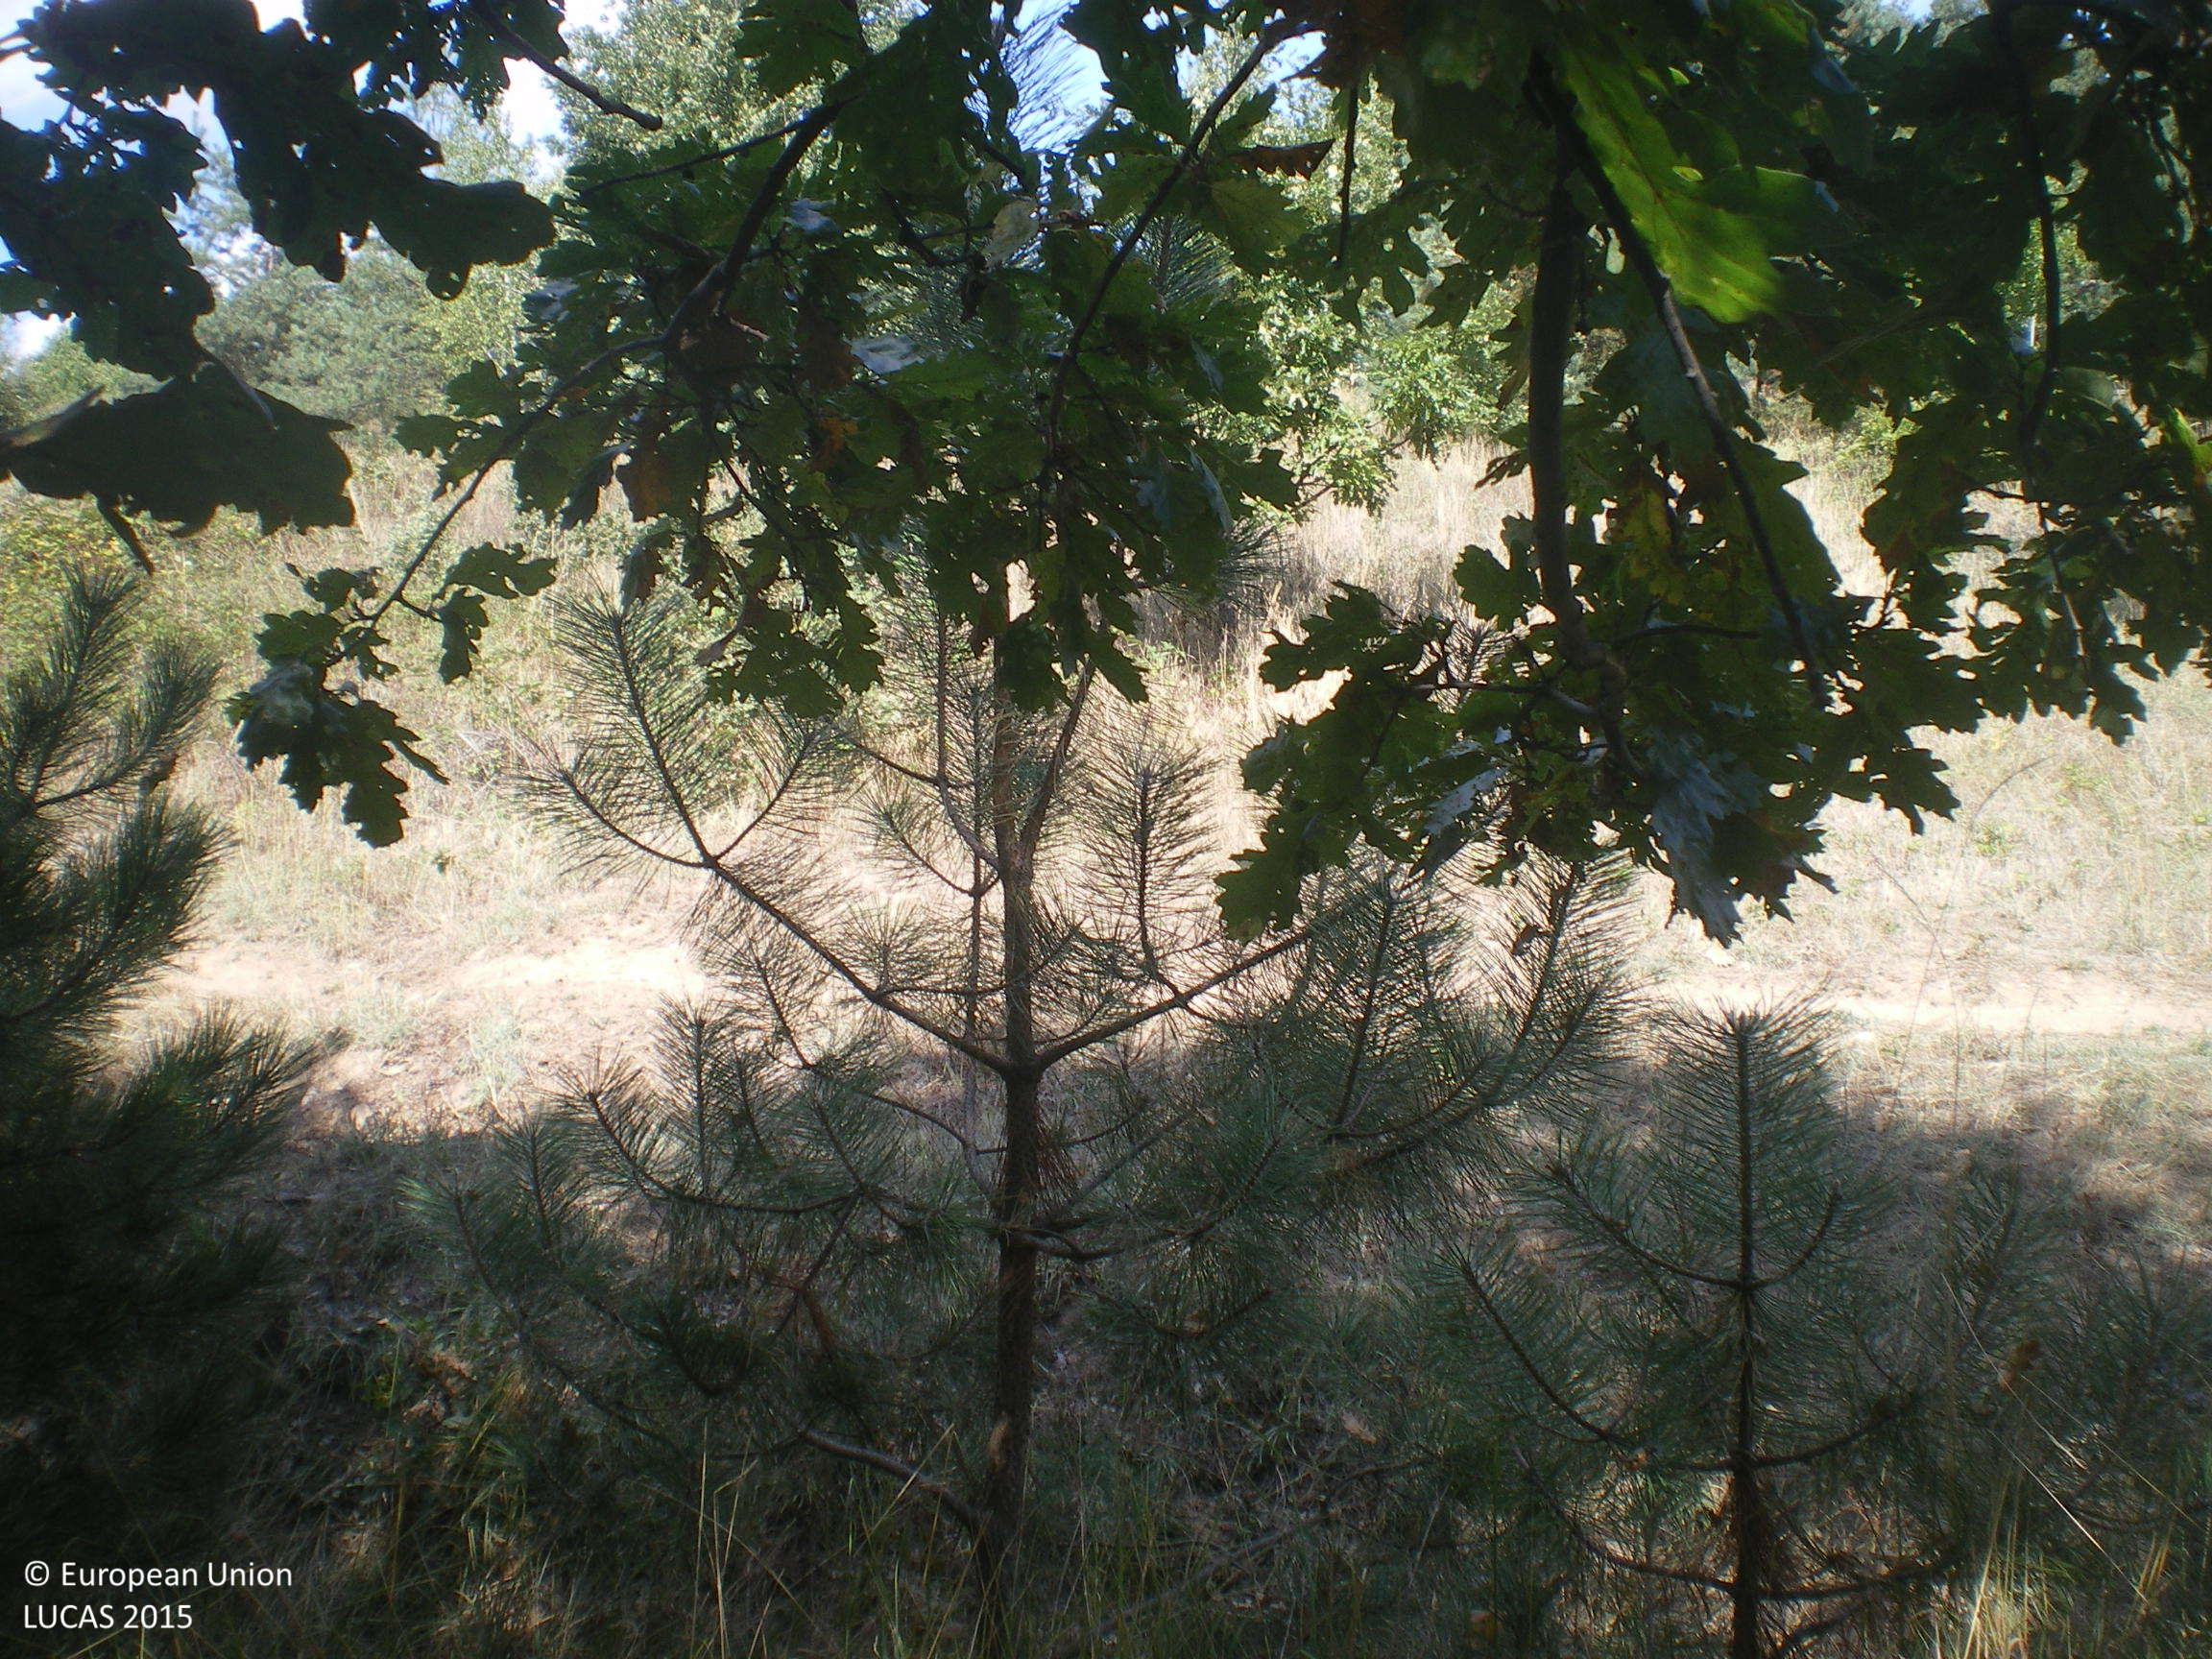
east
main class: Woodland
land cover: Broadleaved woodland
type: mesophytic deciduous forest
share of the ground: > 75 %
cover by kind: broadleaved forest trees 90 %, coniferous forest trees 5 %, herbaceous plants 5 %
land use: Residential
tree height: > 5 m
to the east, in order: Broadleaved woodland; Tracks; Grassland with sparse tree/shrub cover; Broadleaved woodland; Artificial constructions in urban areas; Pine dominated coniferous woodland; Paved roads, cycling and walking lanes; Grass margins; Shrubland without tree cover
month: September
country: BG
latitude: 42.0527
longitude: 26.1114
